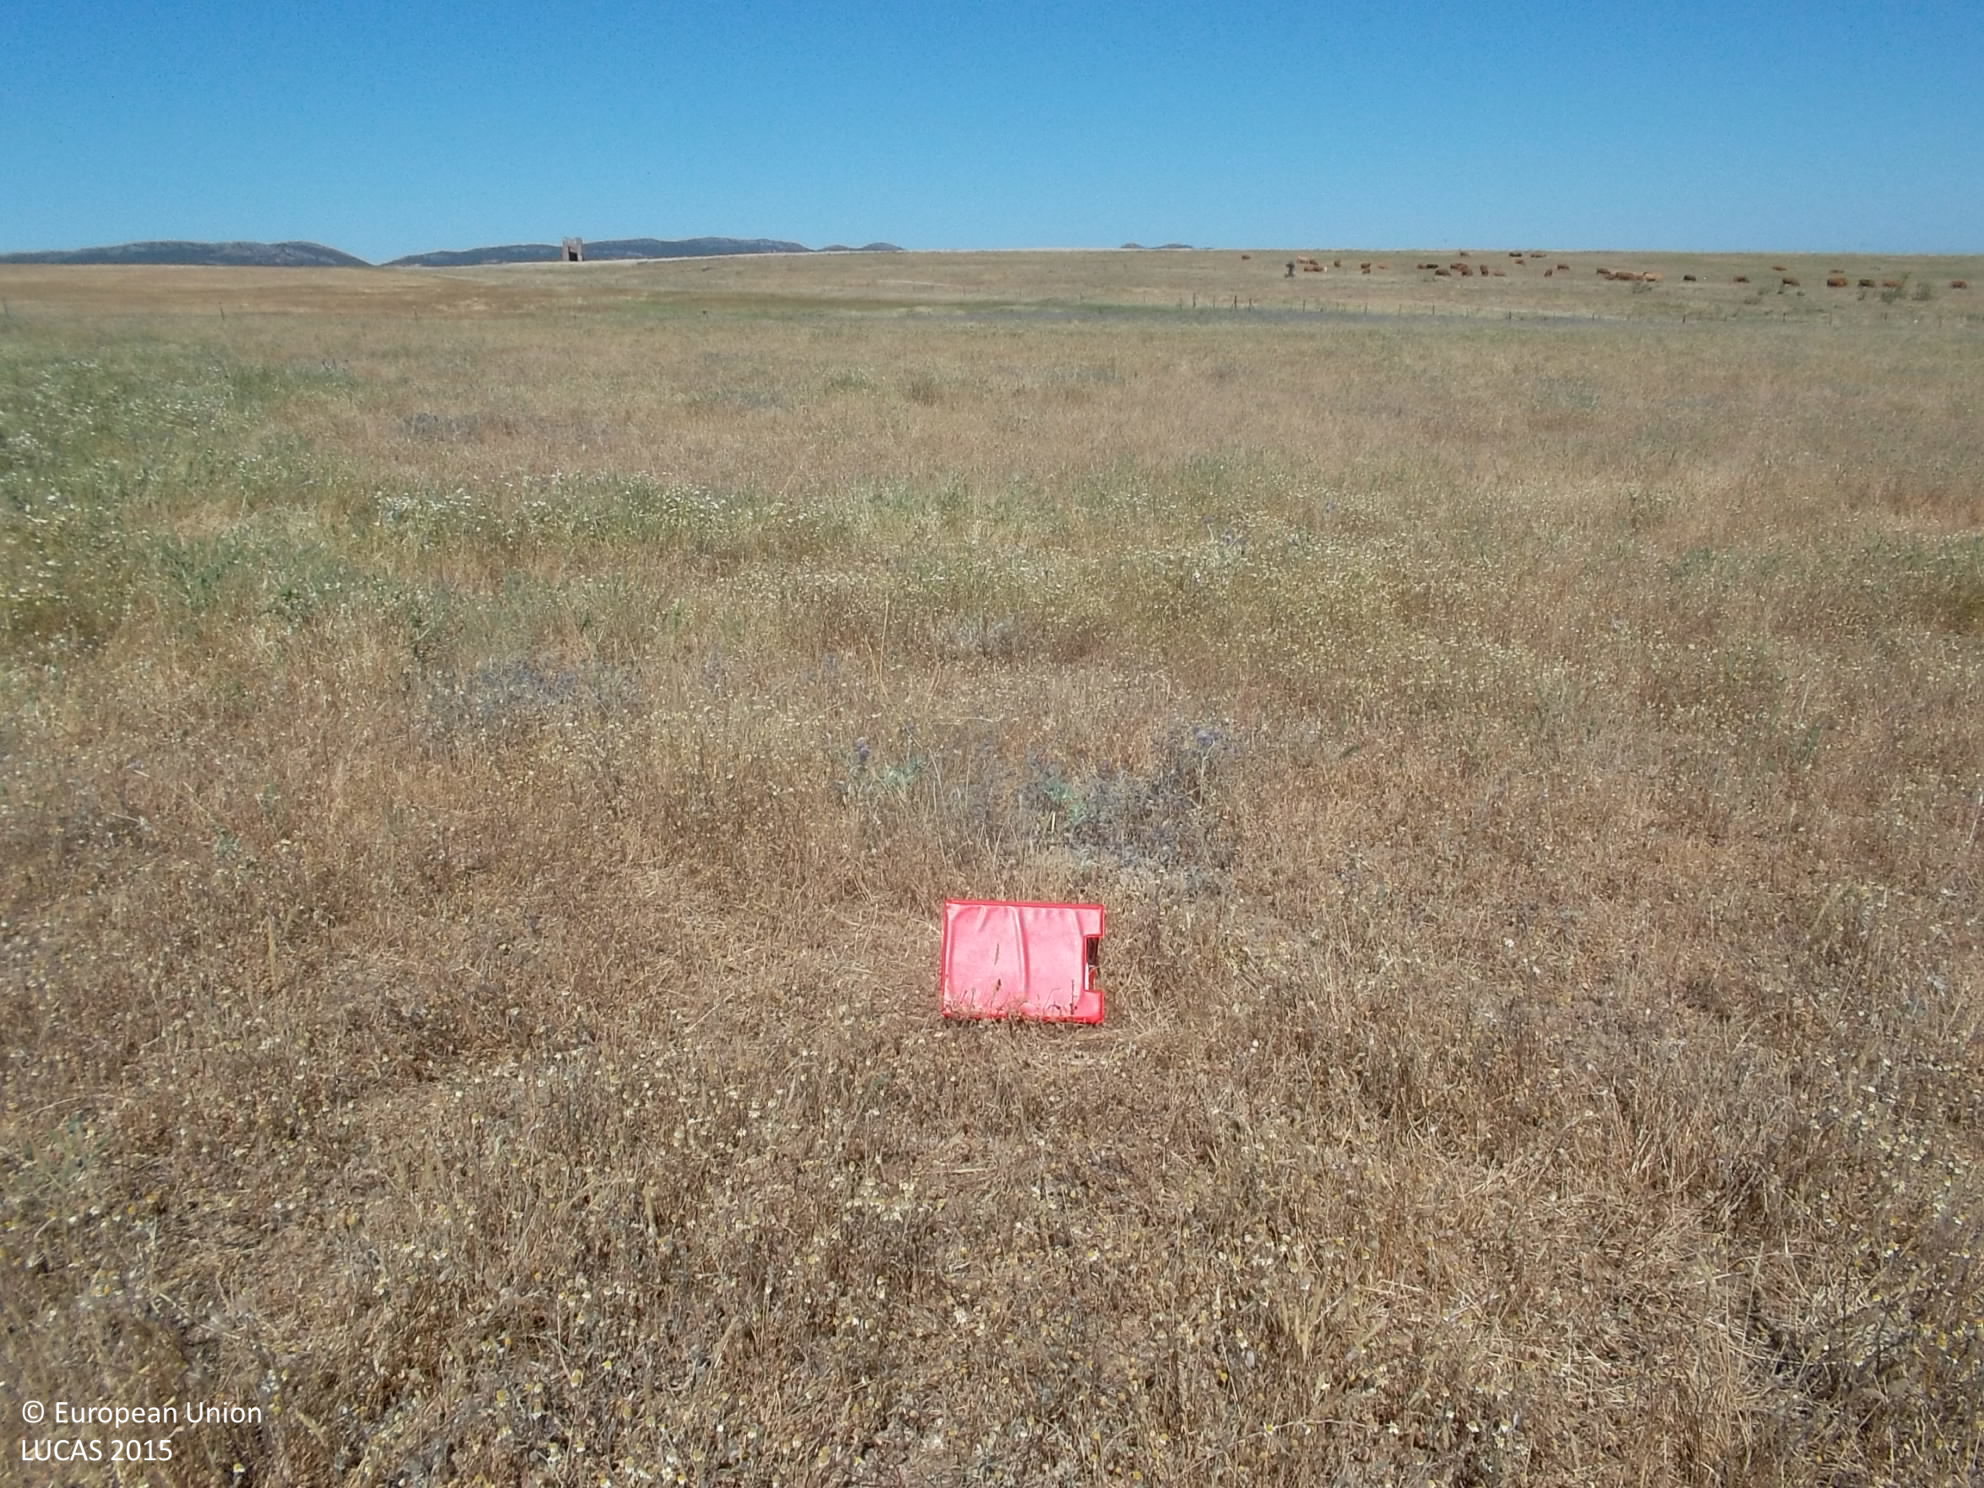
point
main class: Grassland
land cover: Grassland without tree/shrub cover
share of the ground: > 75 %
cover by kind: herbaceous plants 100 %
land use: Agriculture (excluding fallow land and kitchen gardens)
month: May
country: ES
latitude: 38.6099
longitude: -4.4103
